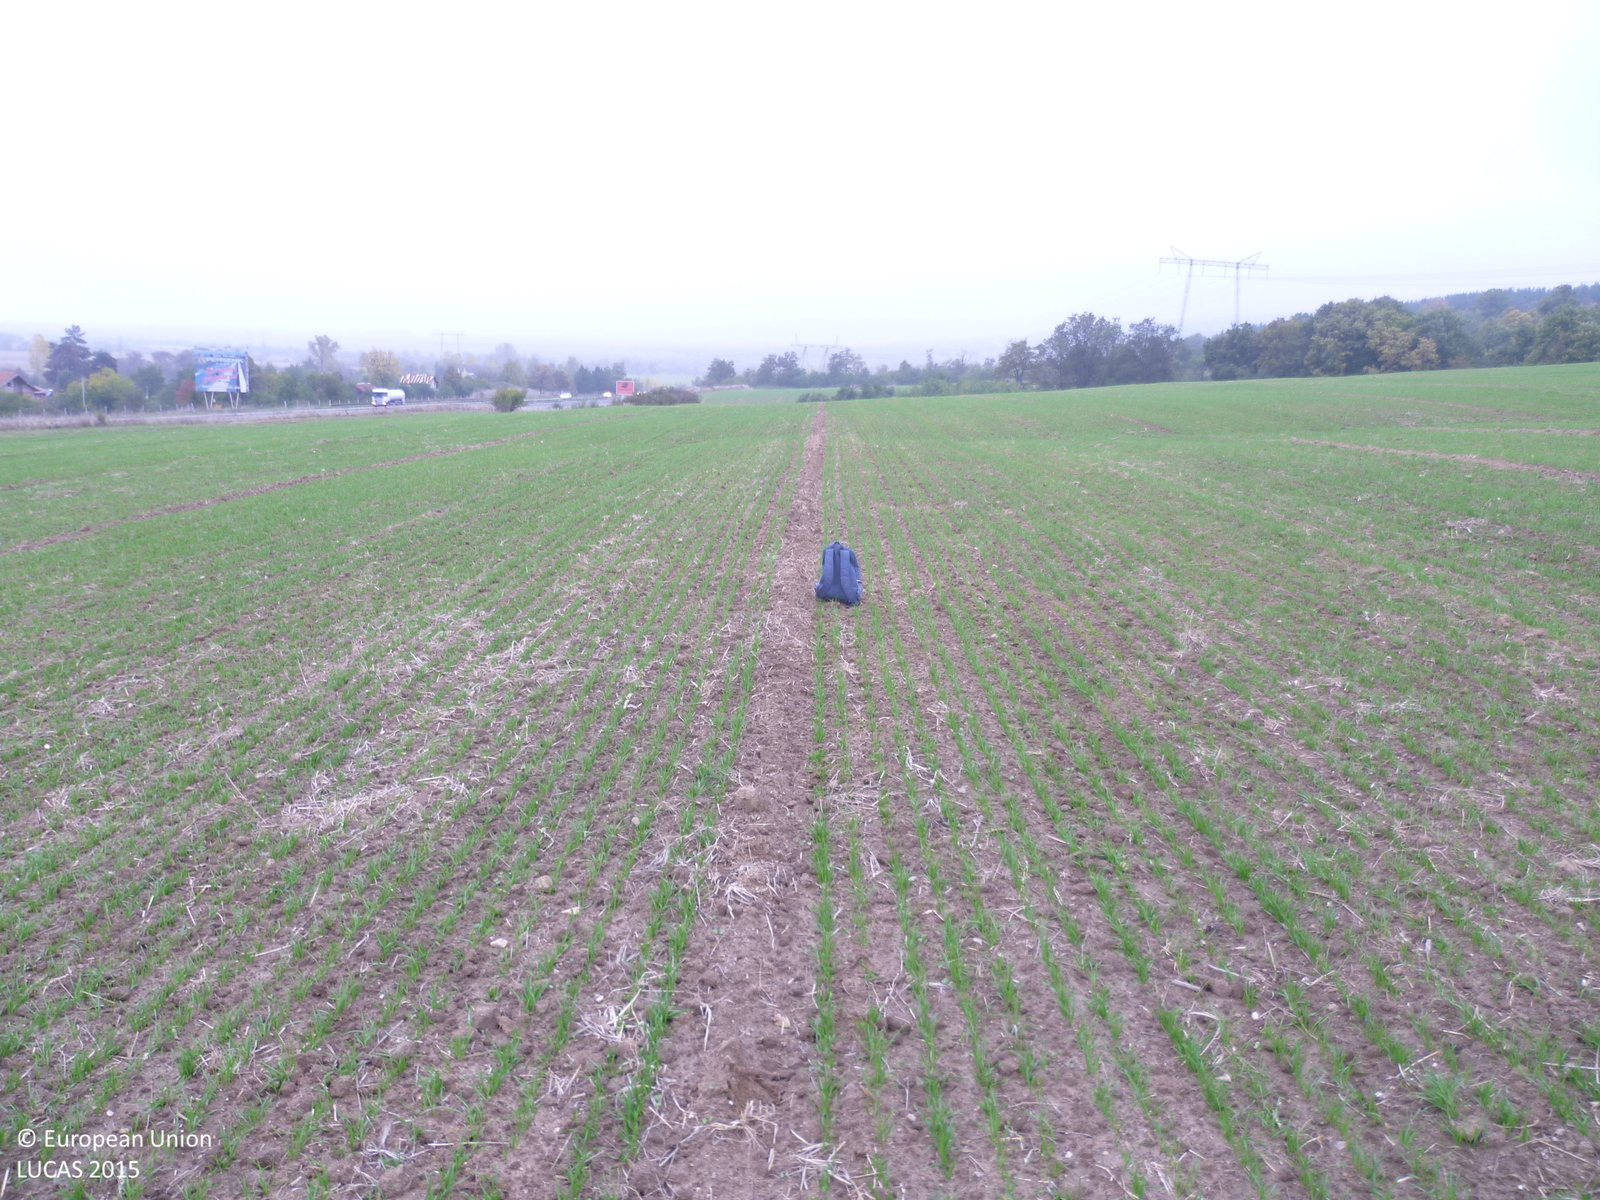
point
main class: Cropland
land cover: Durum wheat
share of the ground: 25 - 50 %
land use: Agriculture (excluding fallow land and kitchen gardens)
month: October
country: BG
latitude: 42.3891
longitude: 23.8750
